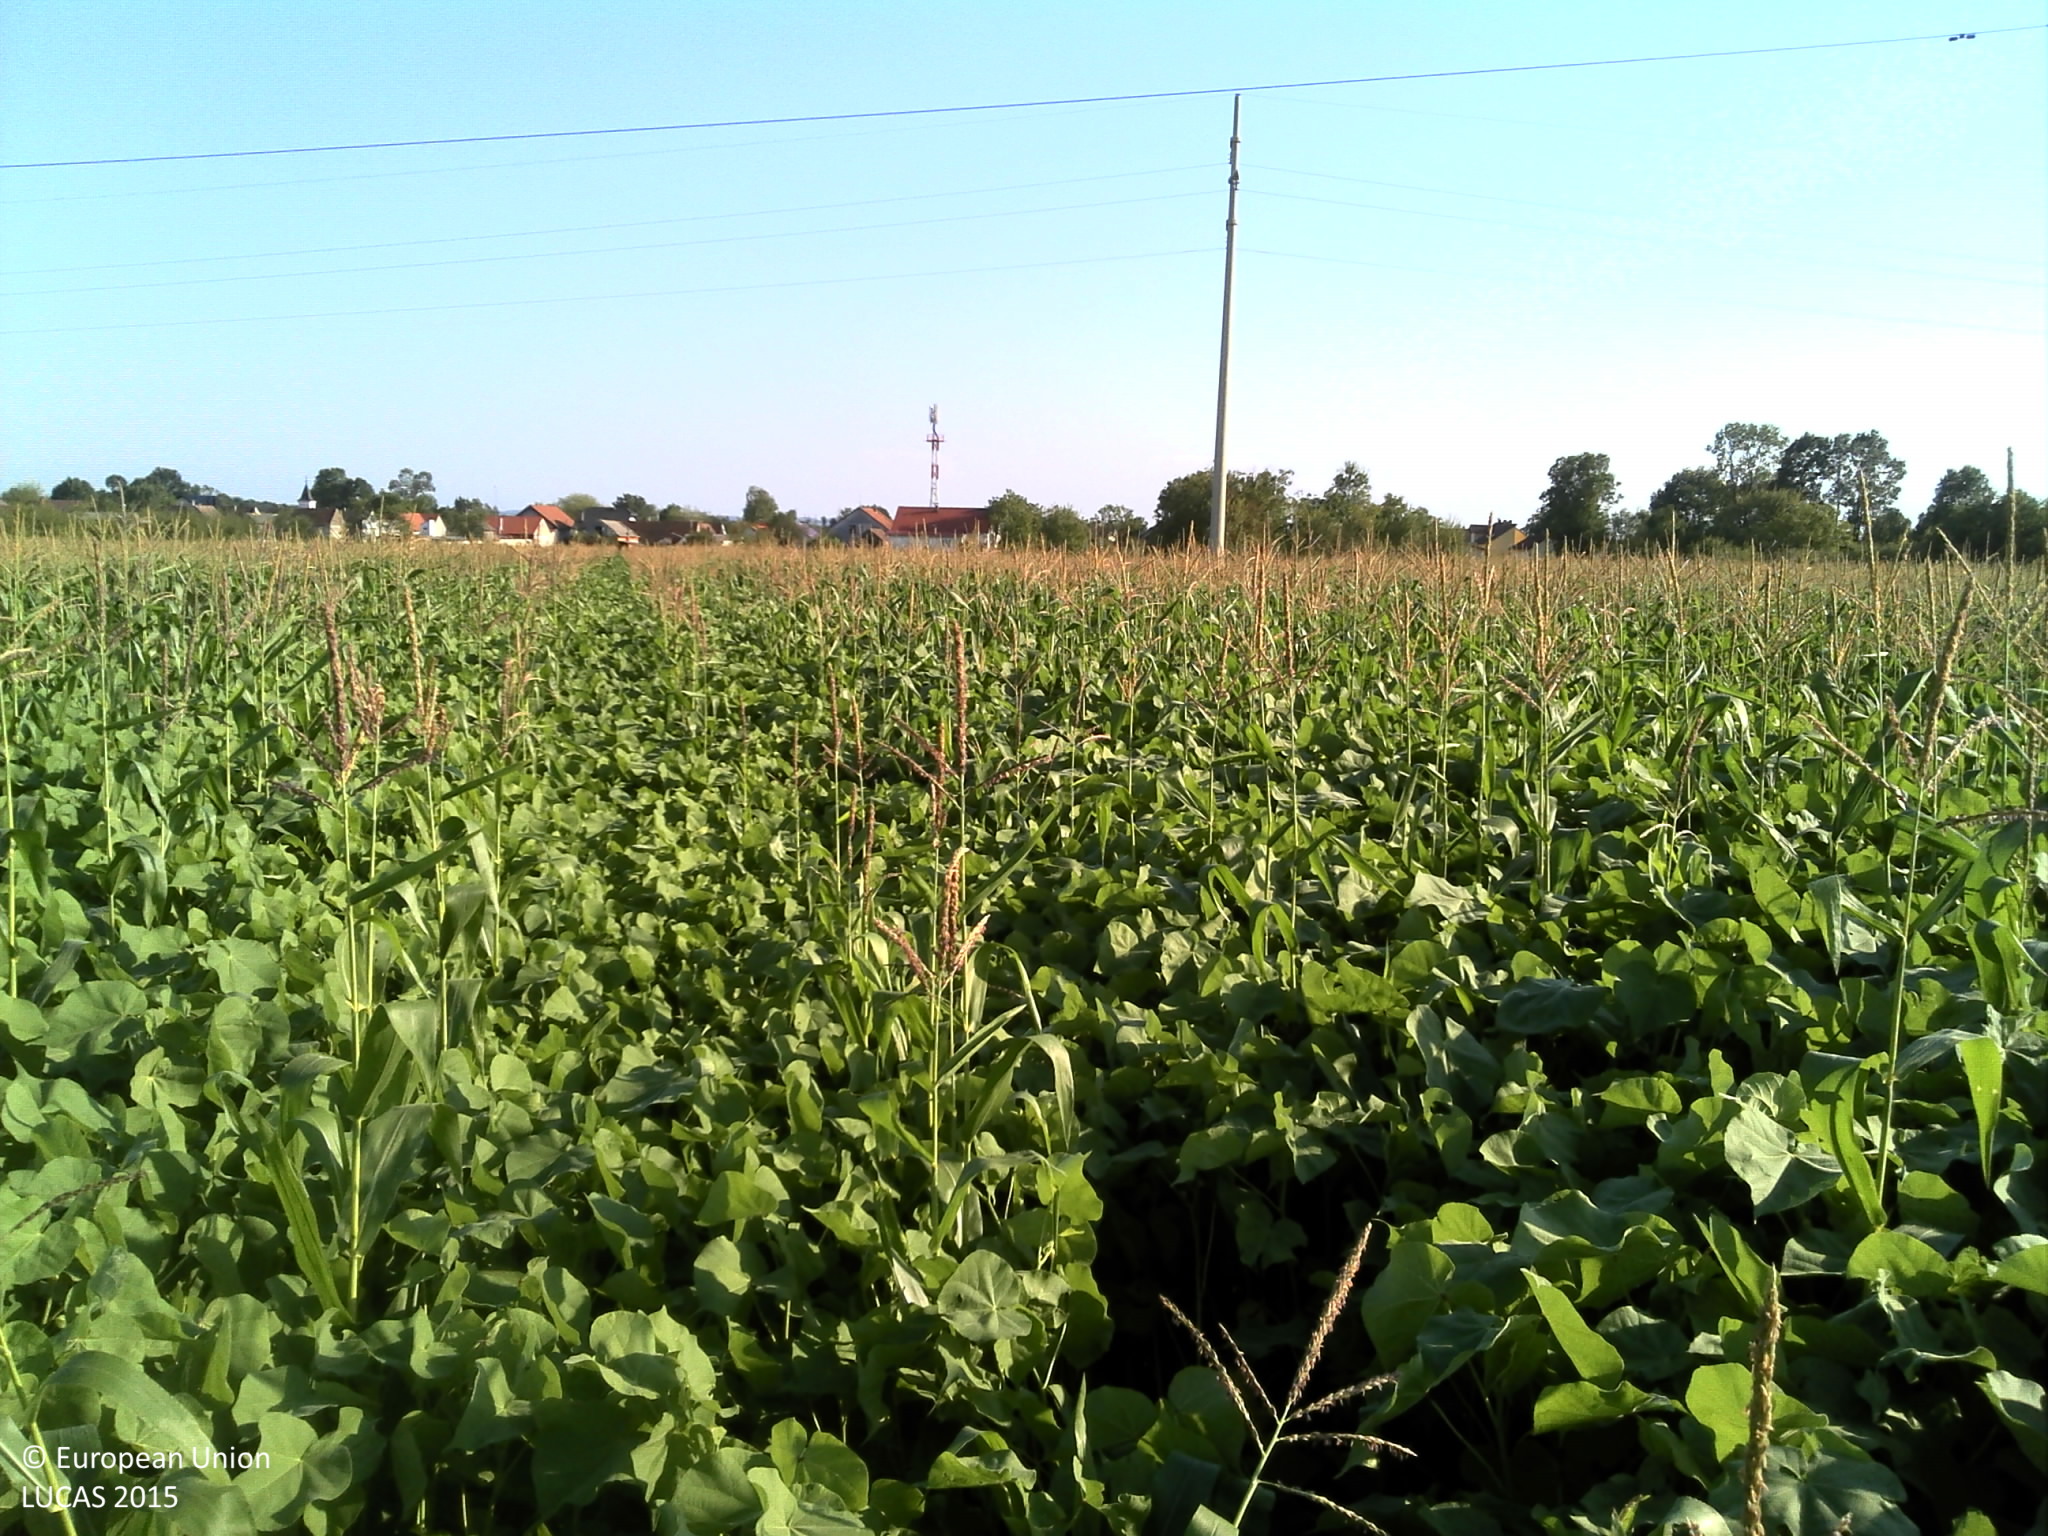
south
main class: Cropland
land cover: Maize
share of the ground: 25 - 50 %
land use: Agriculture (excluding fallow land and kitchen gardens)
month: August
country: HR
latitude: 45.1880
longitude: 18.1616
